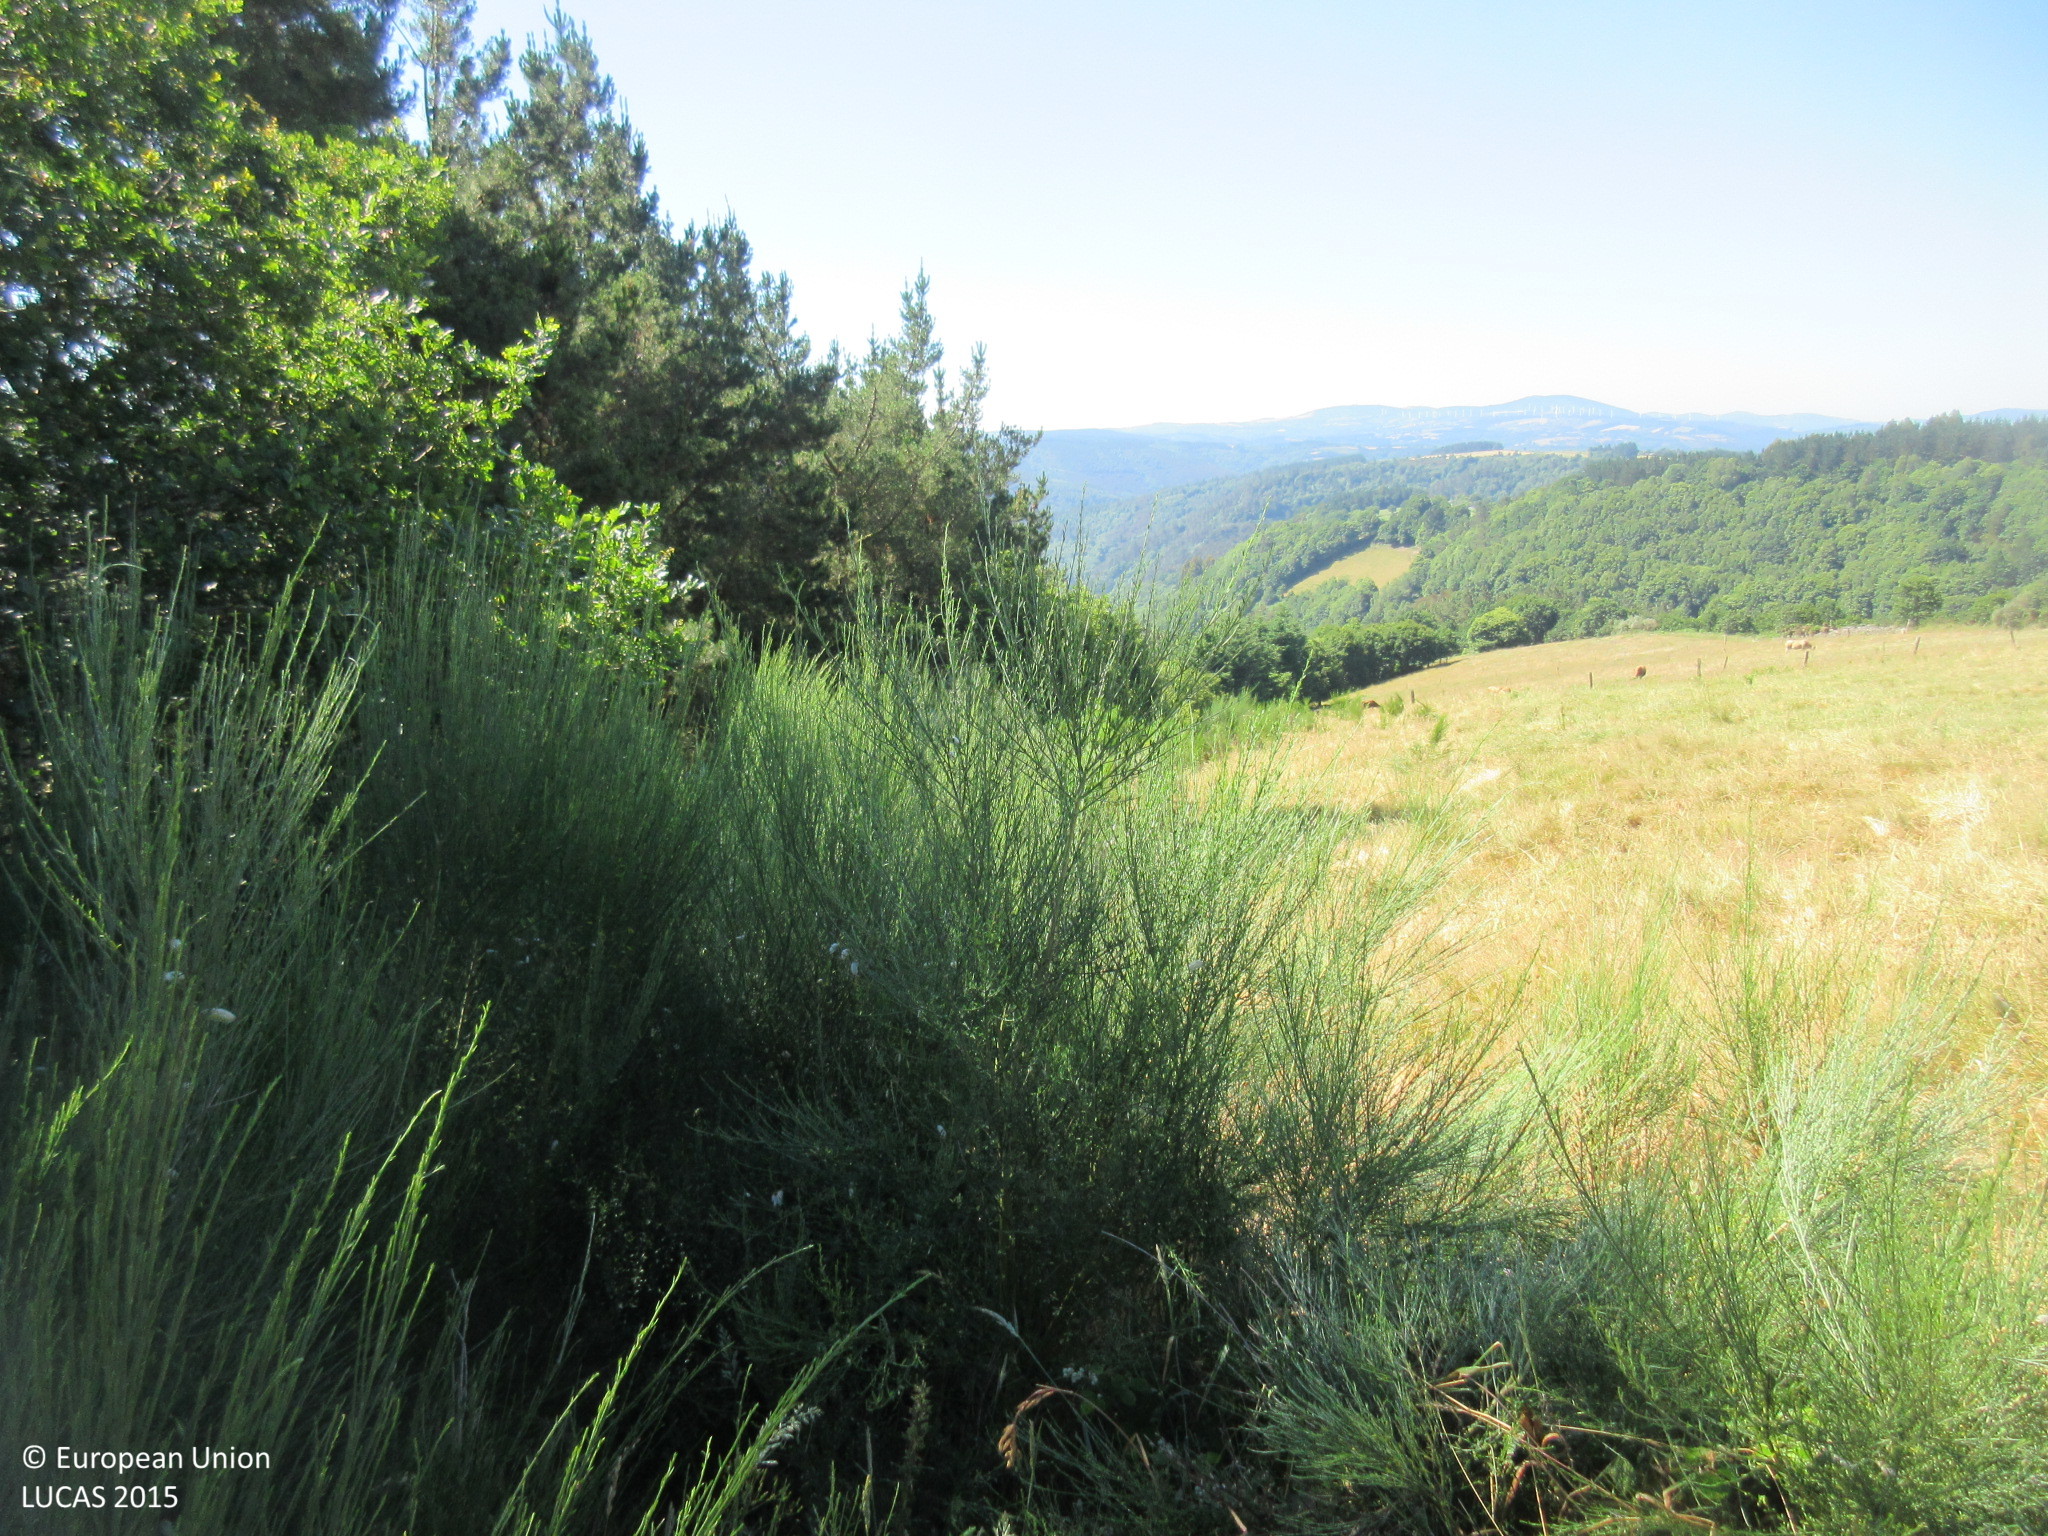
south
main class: Woodland
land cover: Pine dominated coniferous woodland
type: hemiboreal forest and nemoral coniferous forest and mixed broadleaved-coniferous forest
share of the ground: > 75 %
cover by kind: coniferous forest trees 90 %, broadleaved forest trees 10 %
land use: Forestry
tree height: > 5 m
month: June
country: ES
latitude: 43.2452
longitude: -7.1257
